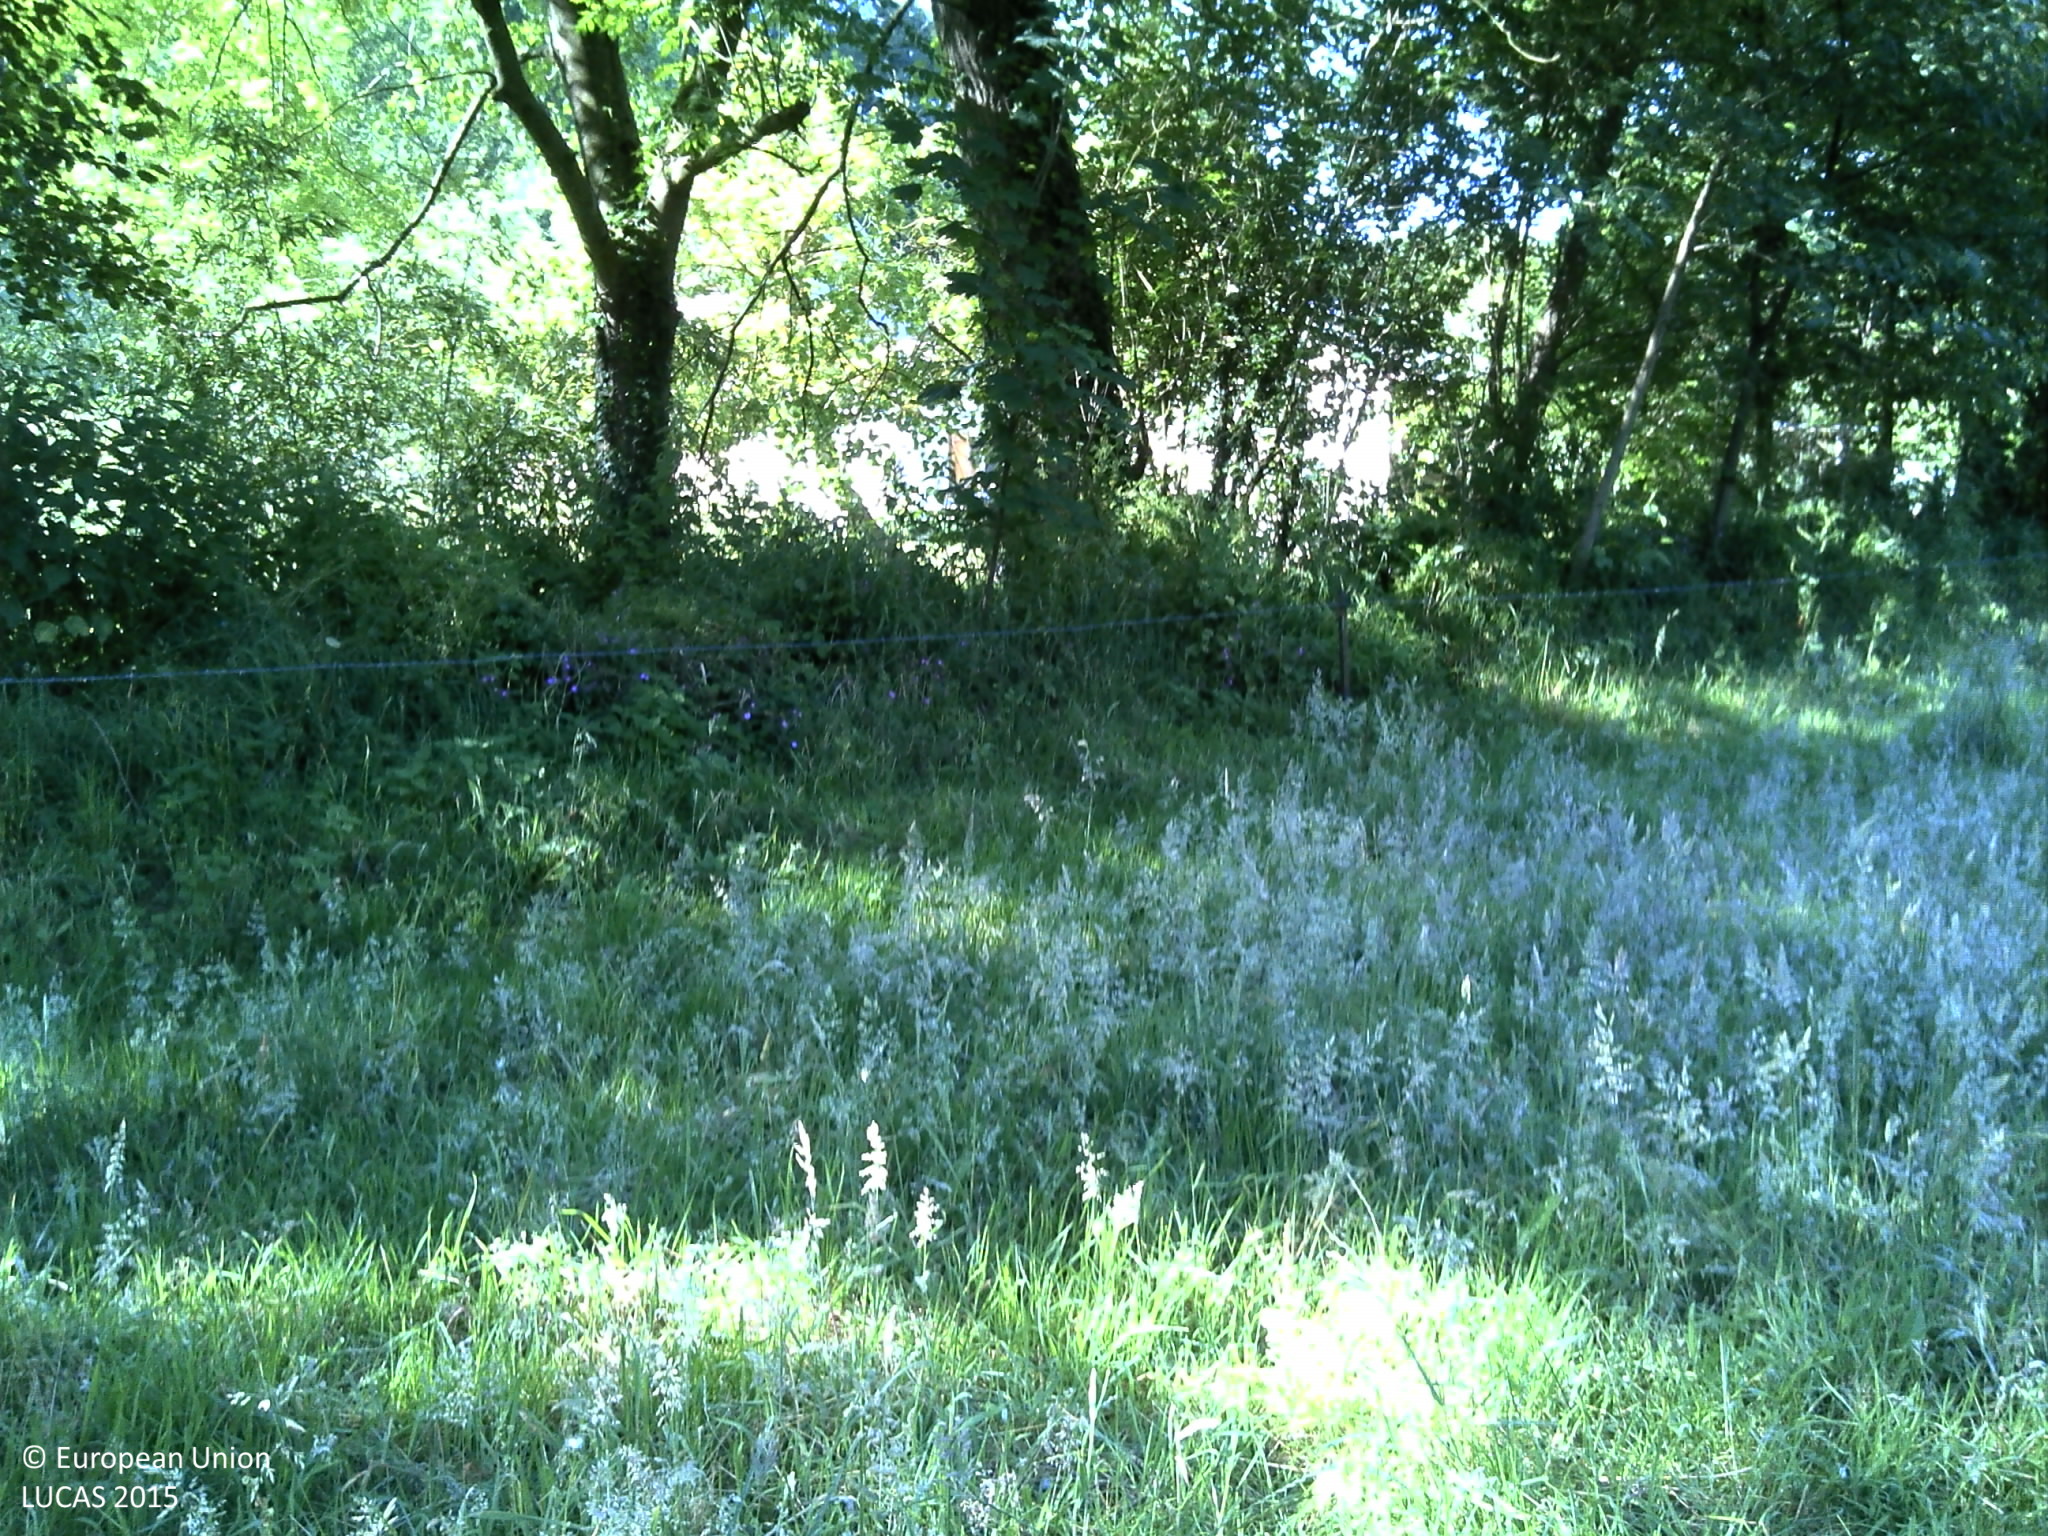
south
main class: Grassland
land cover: Grassland without tree/shrub cover
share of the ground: > 75 %
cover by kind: herbaceous plants 100 %
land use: Agriculture (excluding fallow land and kitchen gardens)
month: June
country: FR
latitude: 49.8085
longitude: 0.9866
